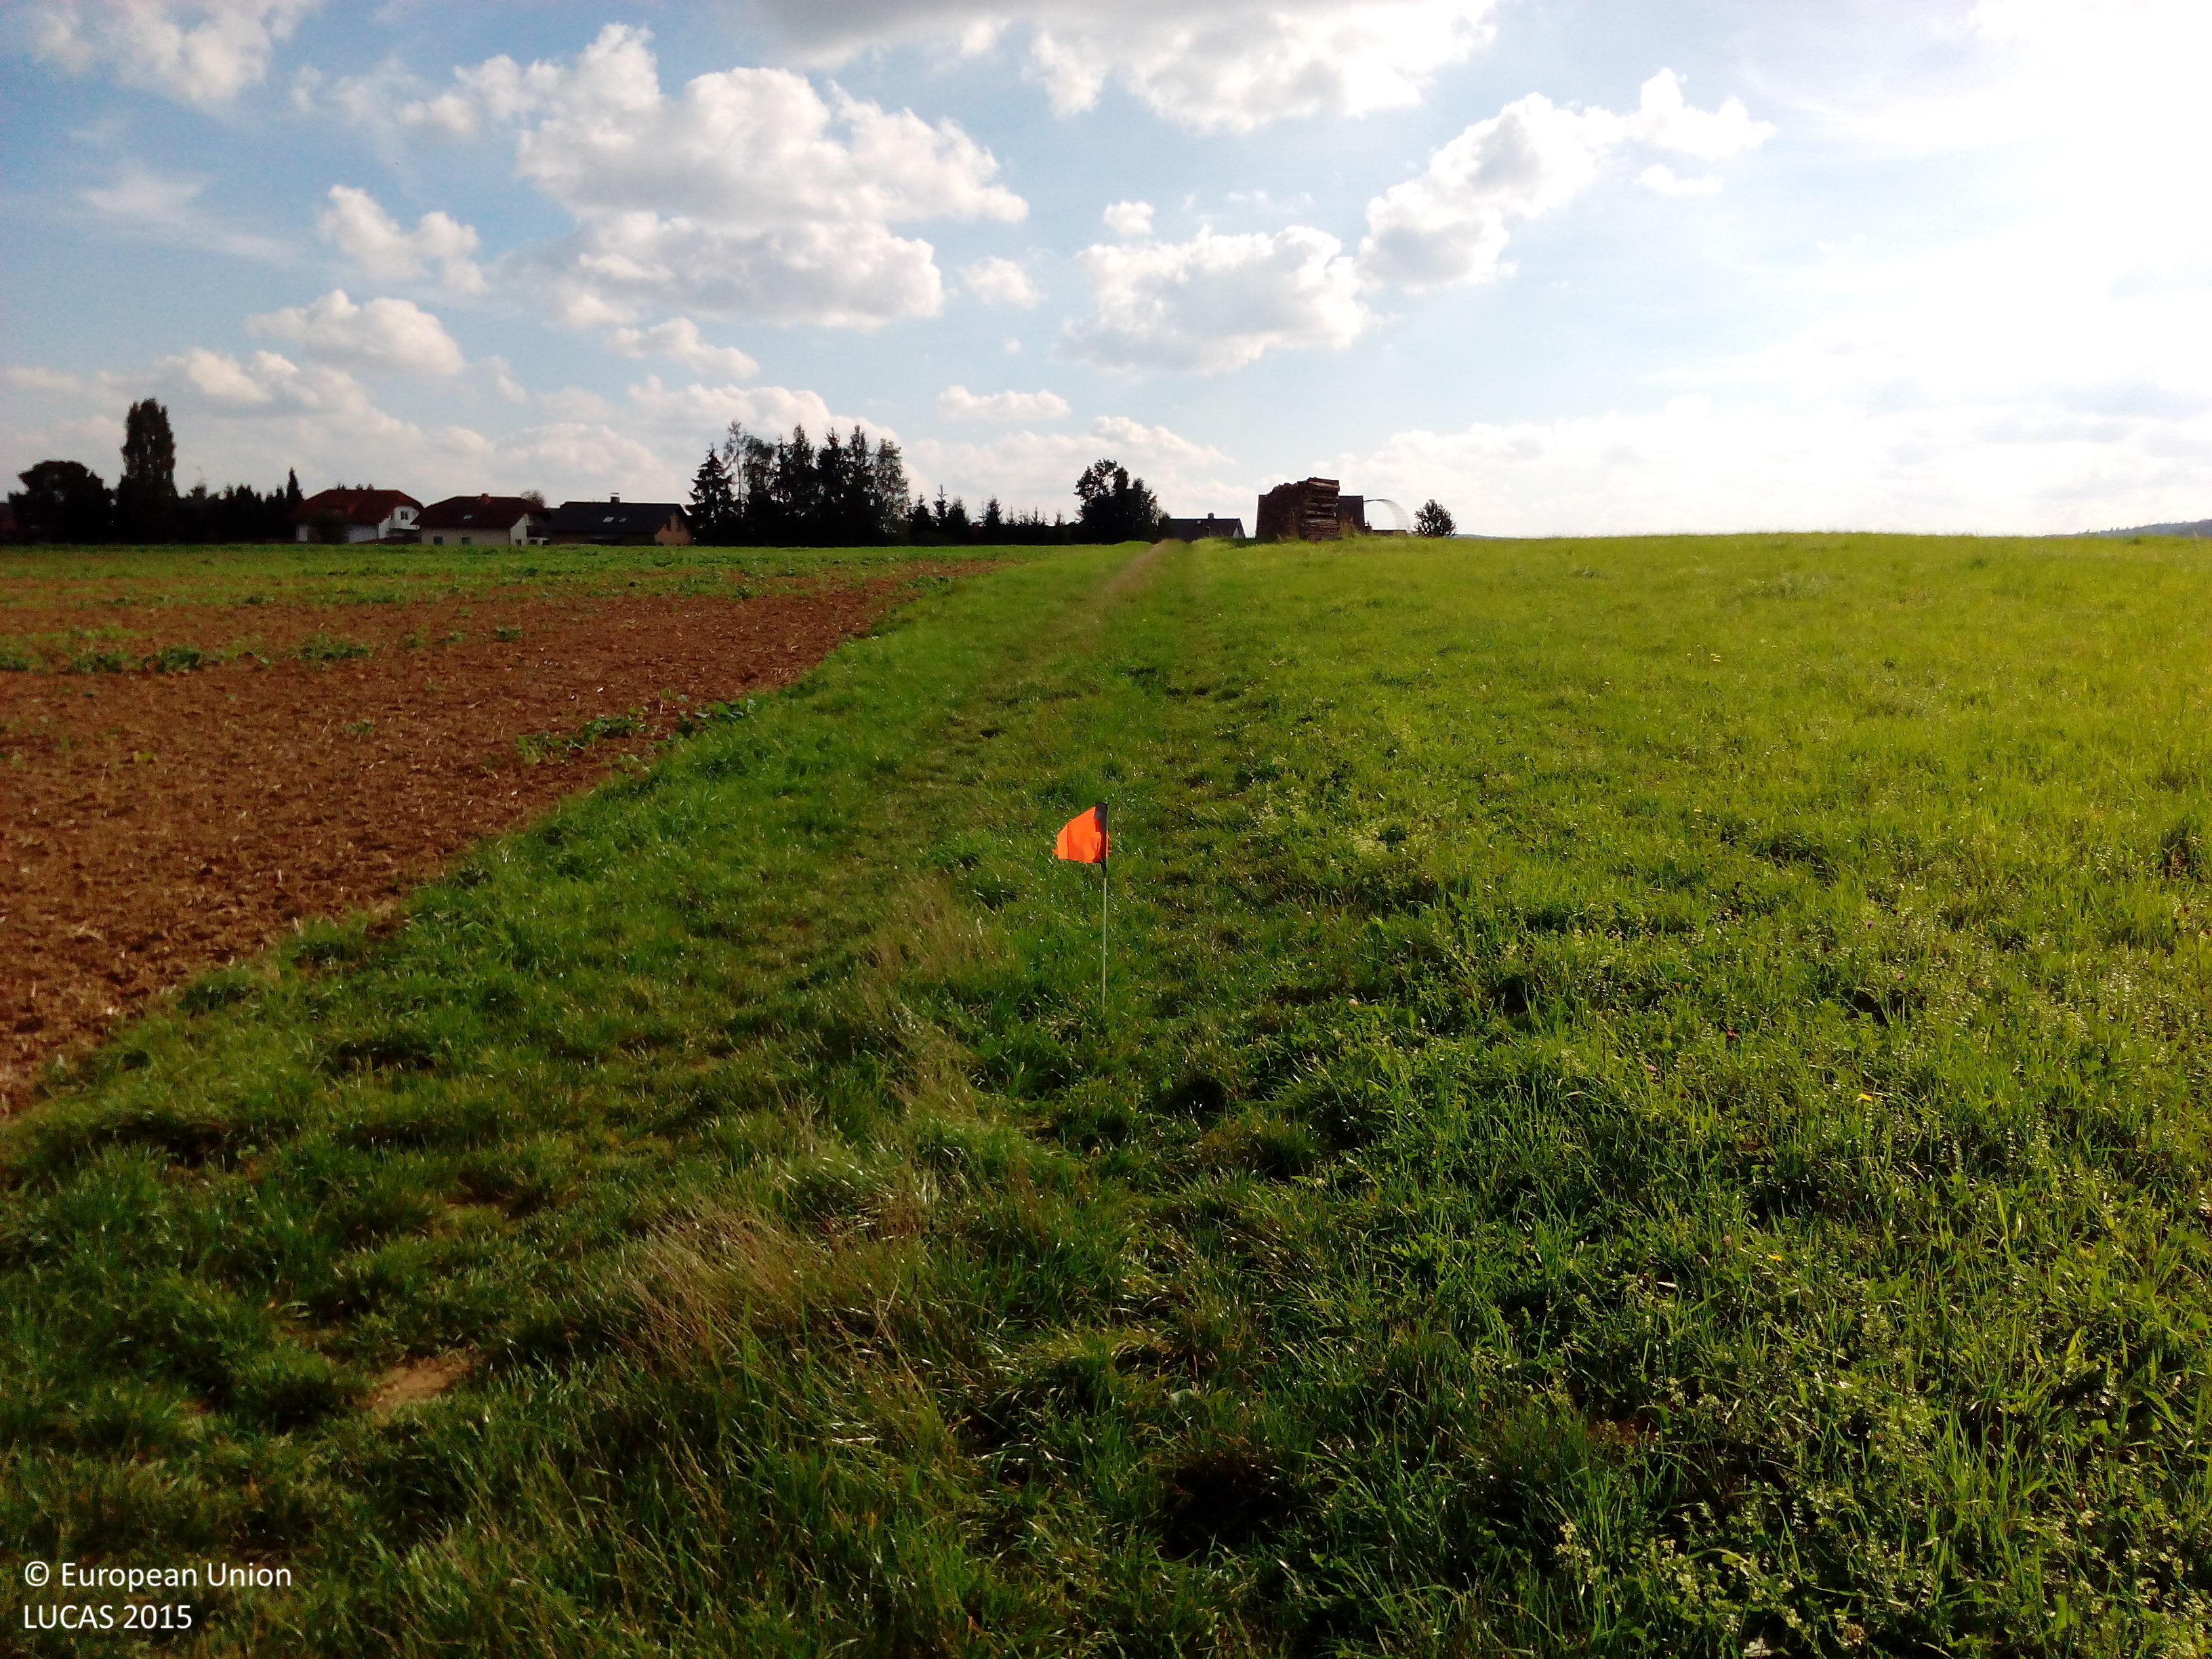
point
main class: Cropland
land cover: Rape and turnip rape
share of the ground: < 10 %
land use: Agriculture (excluding fallow land and kitchen gardens)
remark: Harvested field
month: September
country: DE
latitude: 50.4994
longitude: 8.6046
